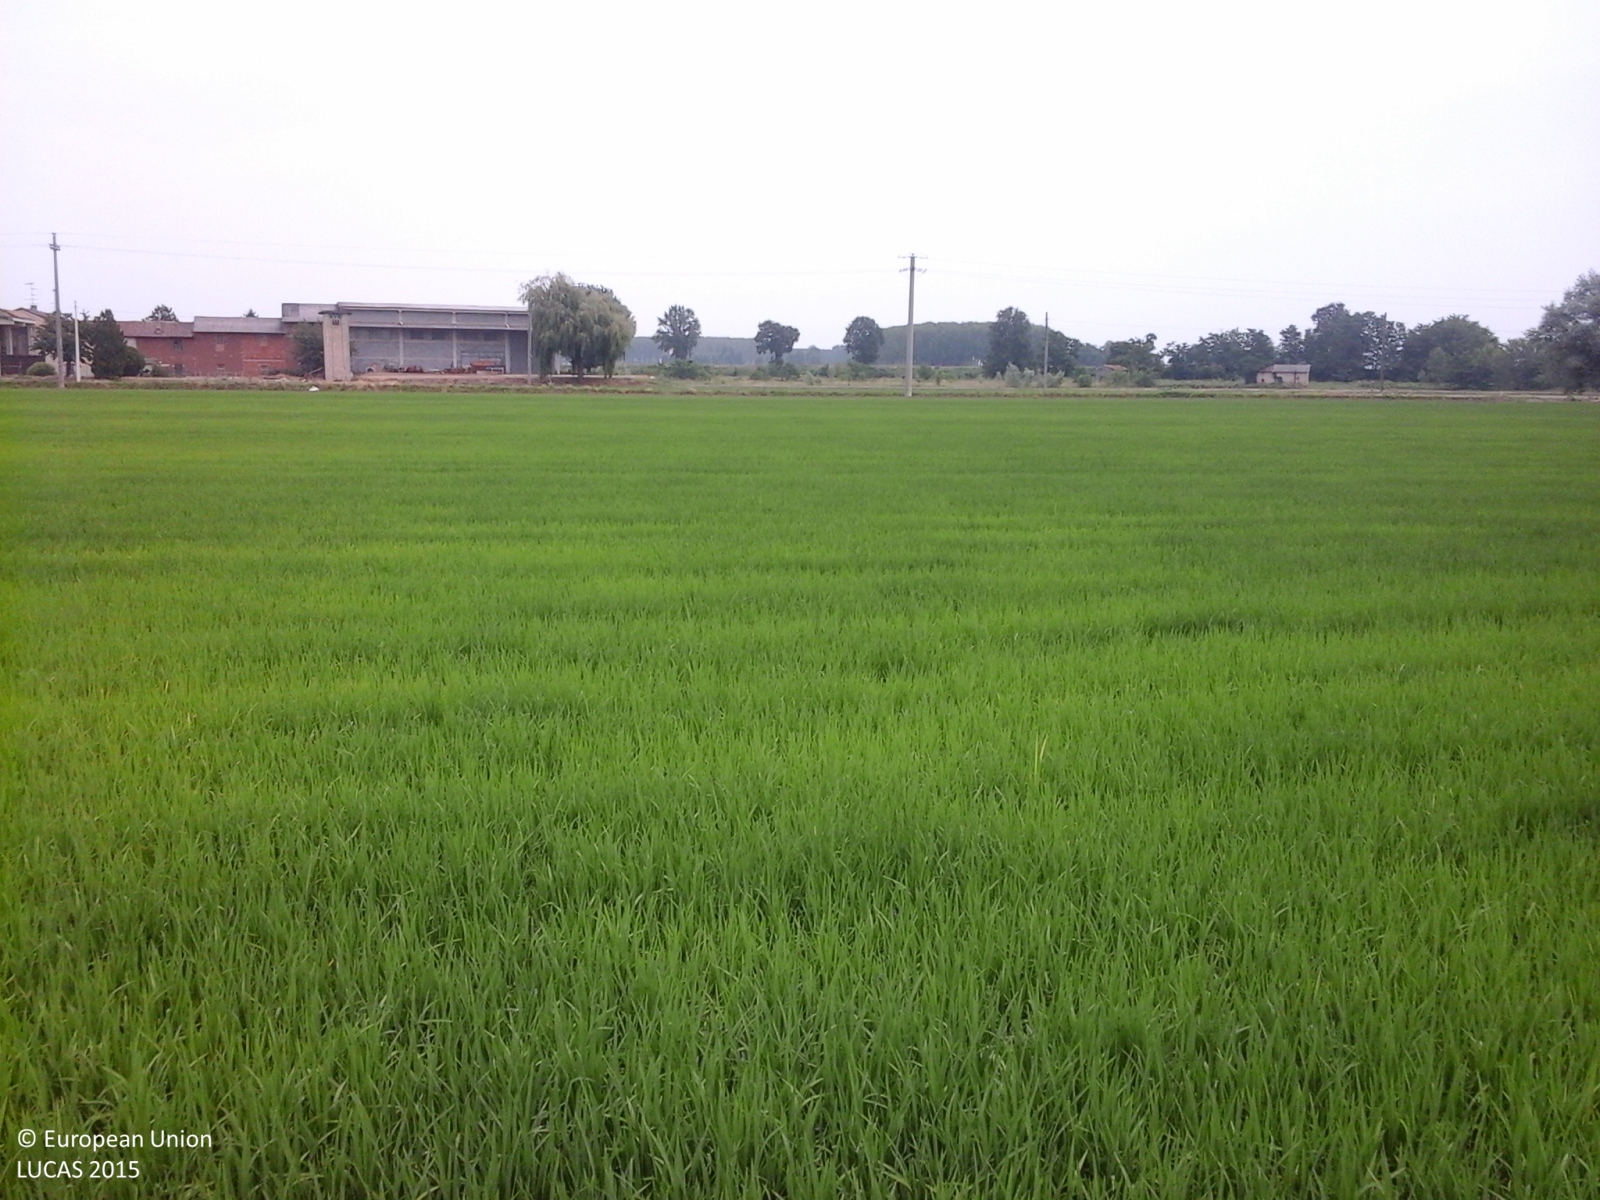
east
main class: Cropland
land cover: Rice
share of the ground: > 75 %
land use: Agriculture (excluding fallow land and kitchen gardens)
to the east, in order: Rice; Electric lines; Ditches and canals; Tracks; Electric lines; Rice; Grass margins; Single bushes/trees; Artificial constructions in urban areas; Single bushes/trees; Grass margins; Rice; Tracks
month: June
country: IT
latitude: 45.3136
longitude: 8.5102
